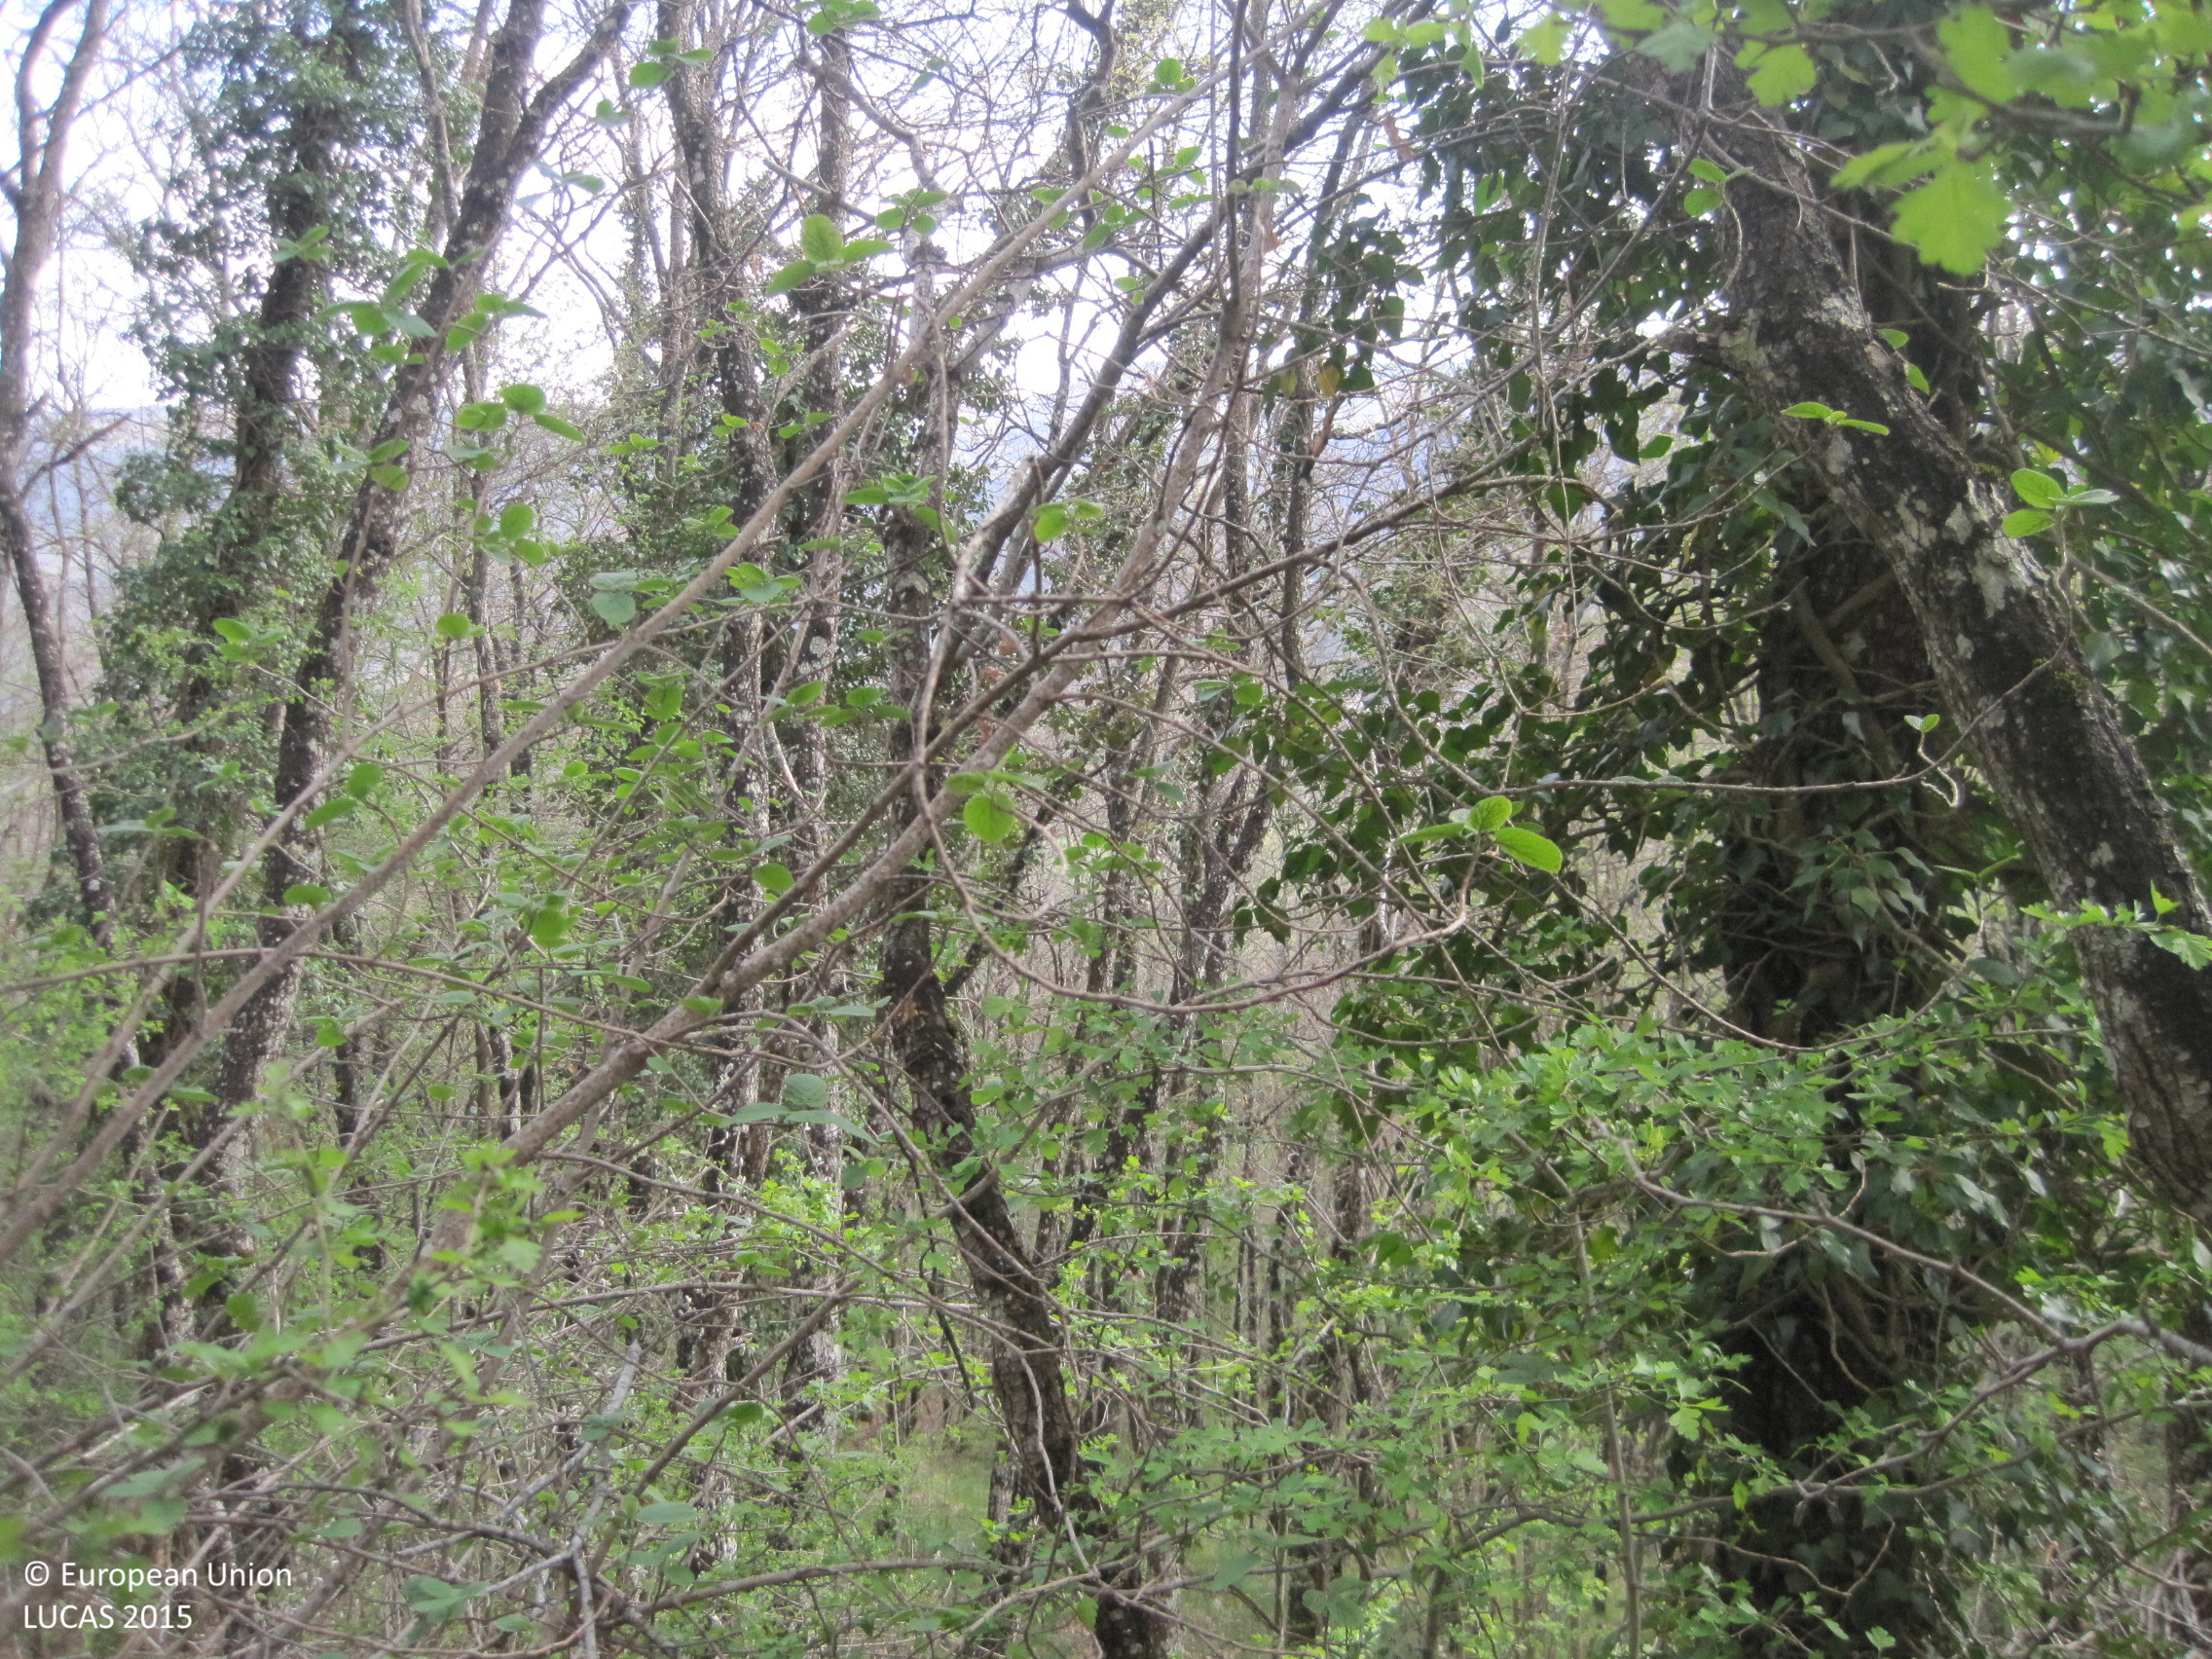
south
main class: Woodland
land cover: Broadleaved woodland
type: acidophilous oak and oak-birch forest
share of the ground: > 75 %
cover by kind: broadleaved forest trees 100 %
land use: Forestry
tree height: > 5 m
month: April
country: ES
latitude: 42.7732
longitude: -2.1809
